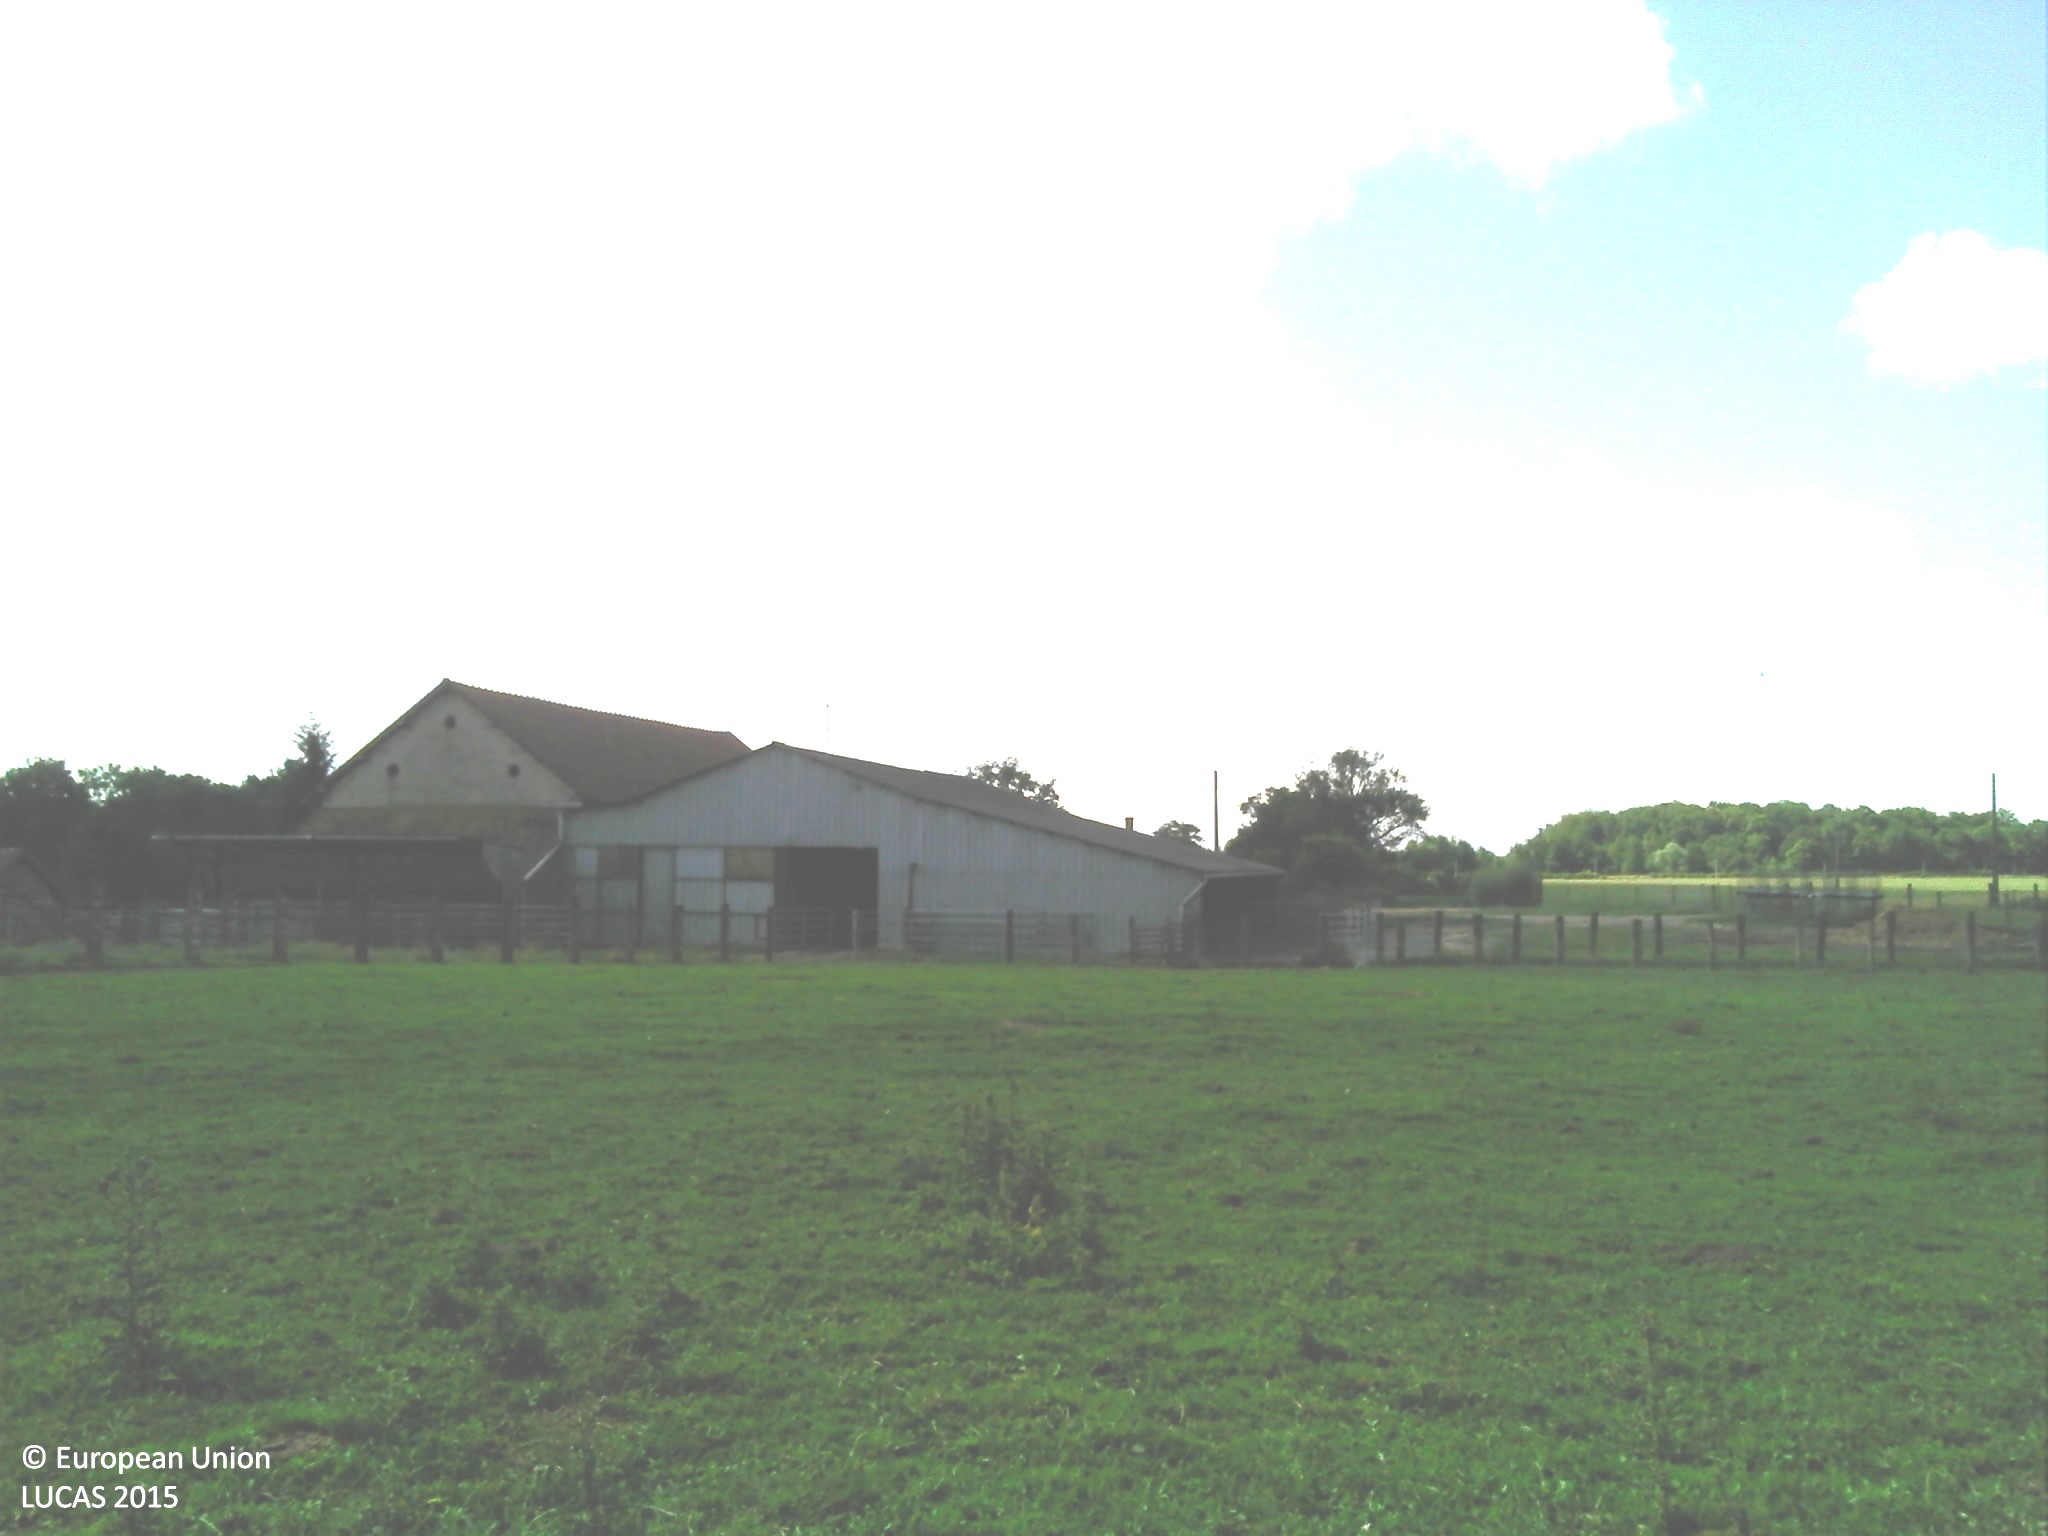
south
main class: Grassland
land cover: Grassland without tree/shrub cover
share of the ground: > 75 %
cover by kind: herbaceous plants 100 %
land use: Agriculture (excluding fallow land and kitchen gardens)
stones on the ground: < 10 %
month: June
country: FR
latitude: 46.7180
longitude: 3.5749
